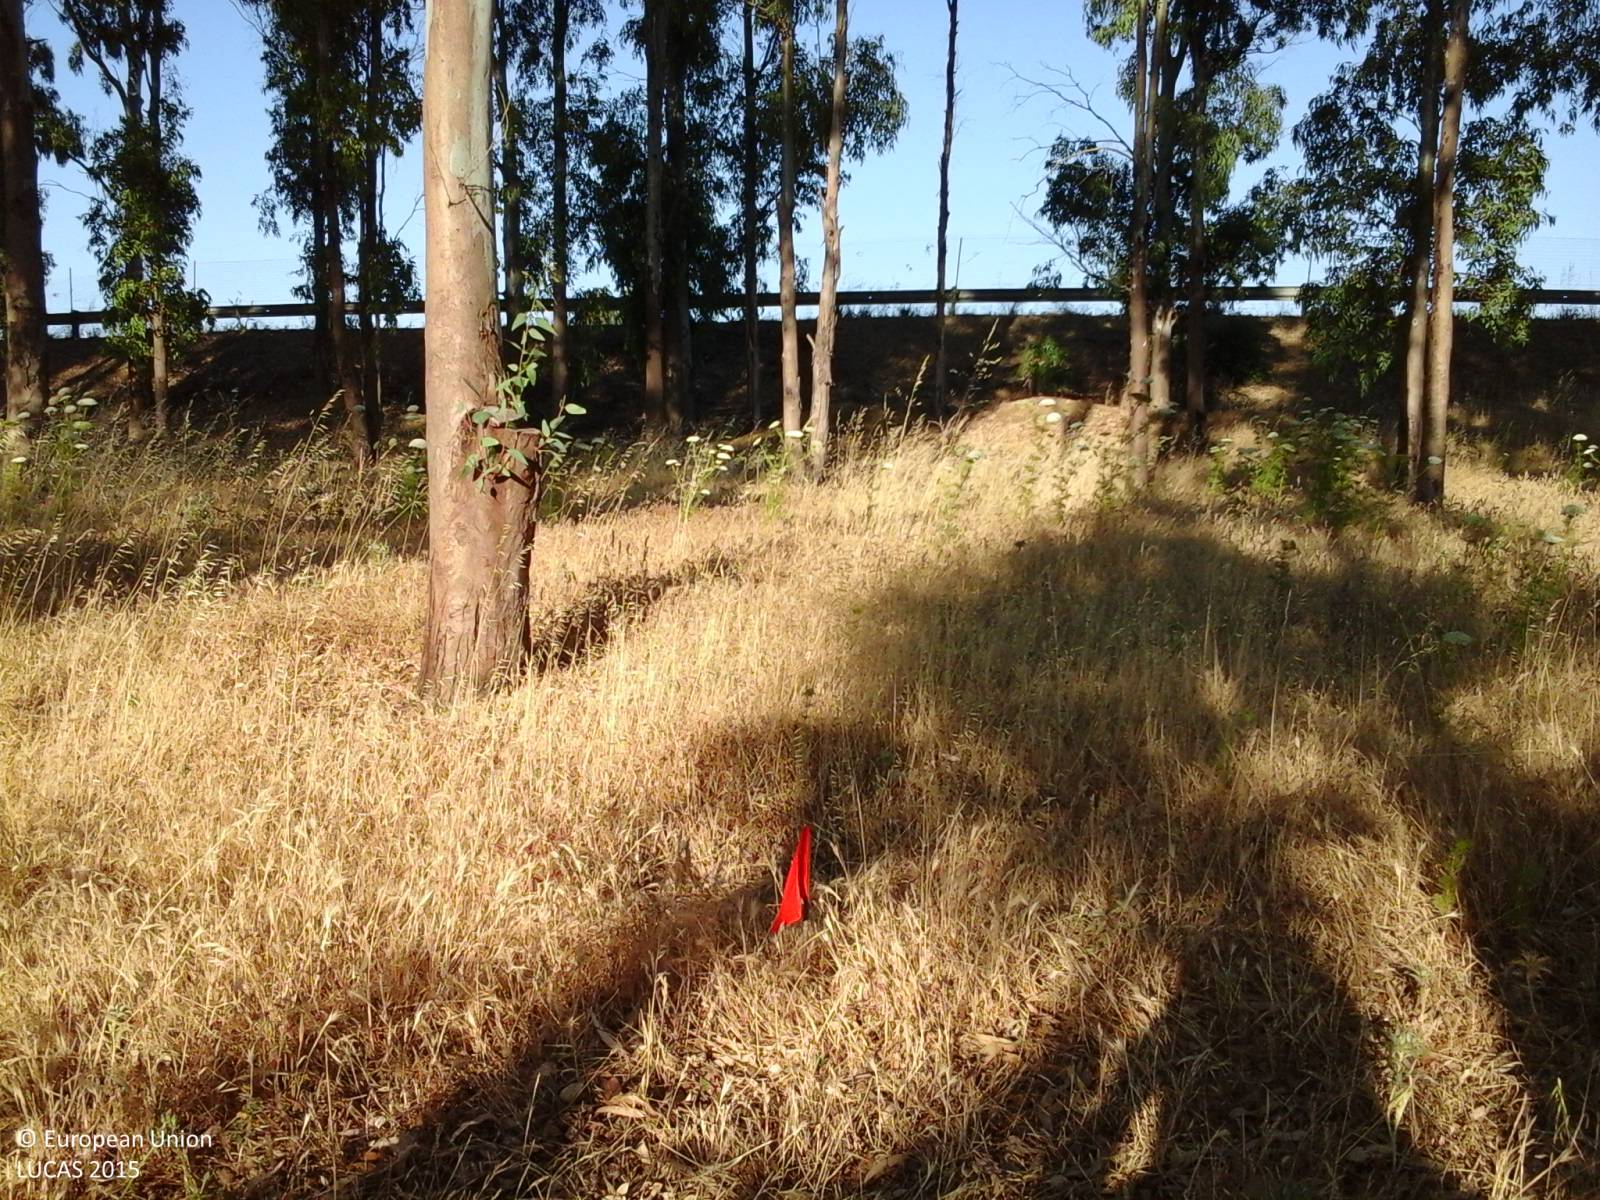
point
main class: Woodland
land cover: Broadleaved woodland
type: broadleaved evergreen forest
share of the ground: 25 - 50 %
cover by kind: broadleaved forest trees 50 %, herbaceous plants 50 %
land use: Forestry
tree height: > 5 m
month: June
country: IT
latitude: 37.9666
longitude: 12.5878
